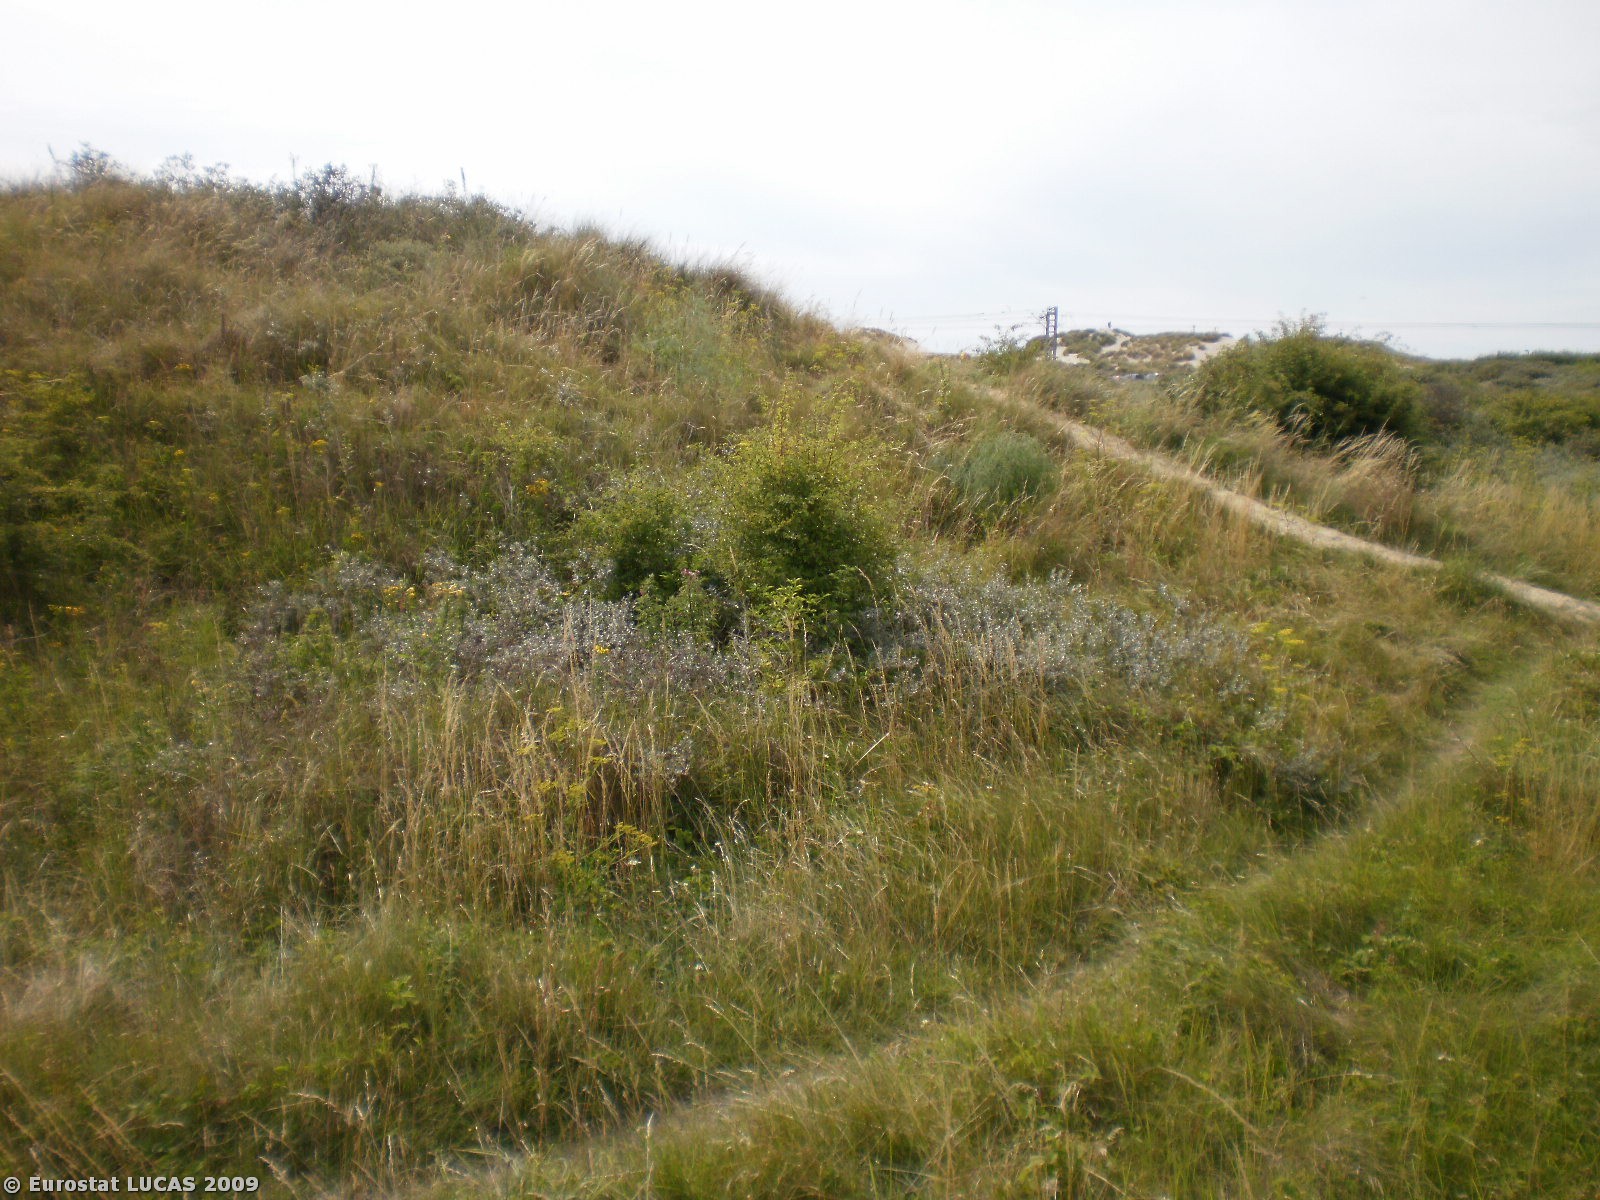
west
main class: Shrubland
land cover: Shrubland with sparse tree cover
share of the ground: 25 - 50 %
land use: Nature reserves
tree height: < 5 m
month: July
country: BE
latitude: 51.1640
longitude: 2.7670
